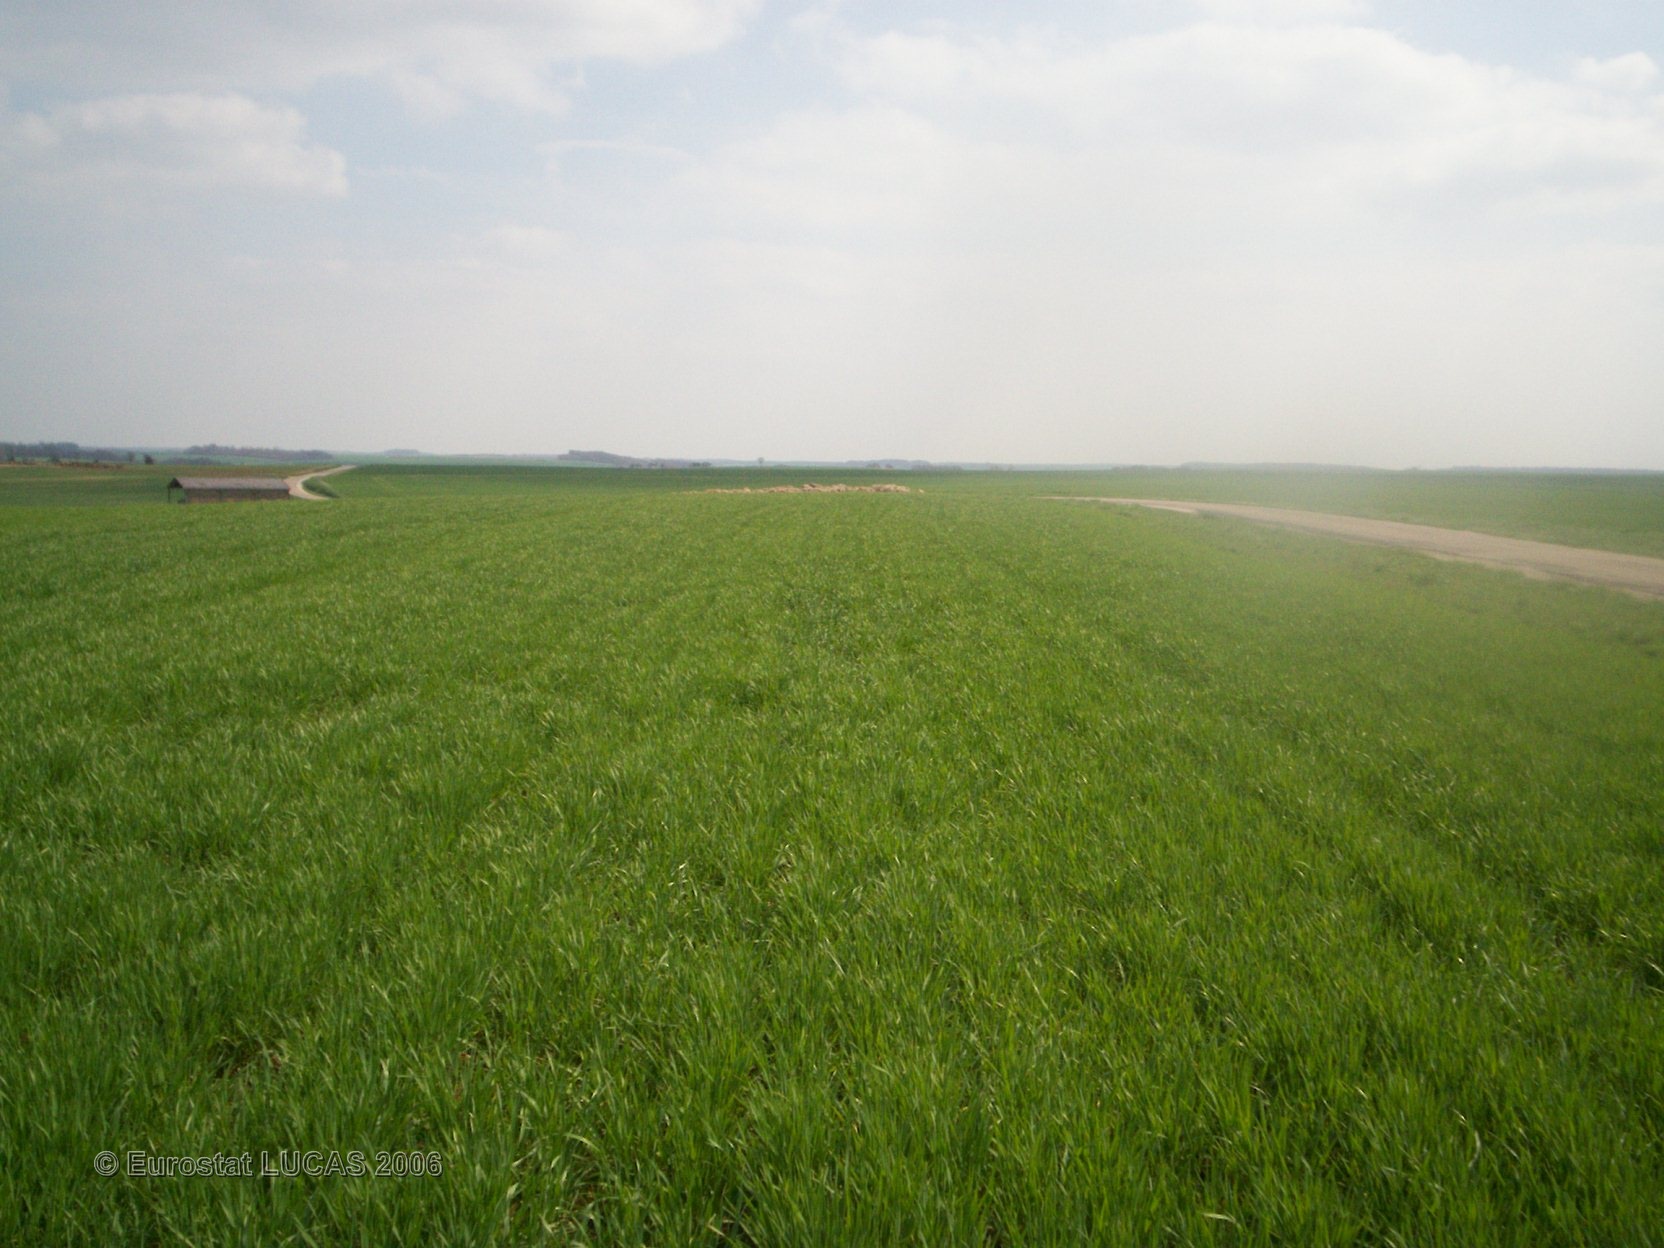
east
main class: Cropland
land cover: Barley
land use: Agriculture (excluding fallow land and kitchen gardens)
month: April
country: FR
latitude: 48.8383
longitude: 5.1616
